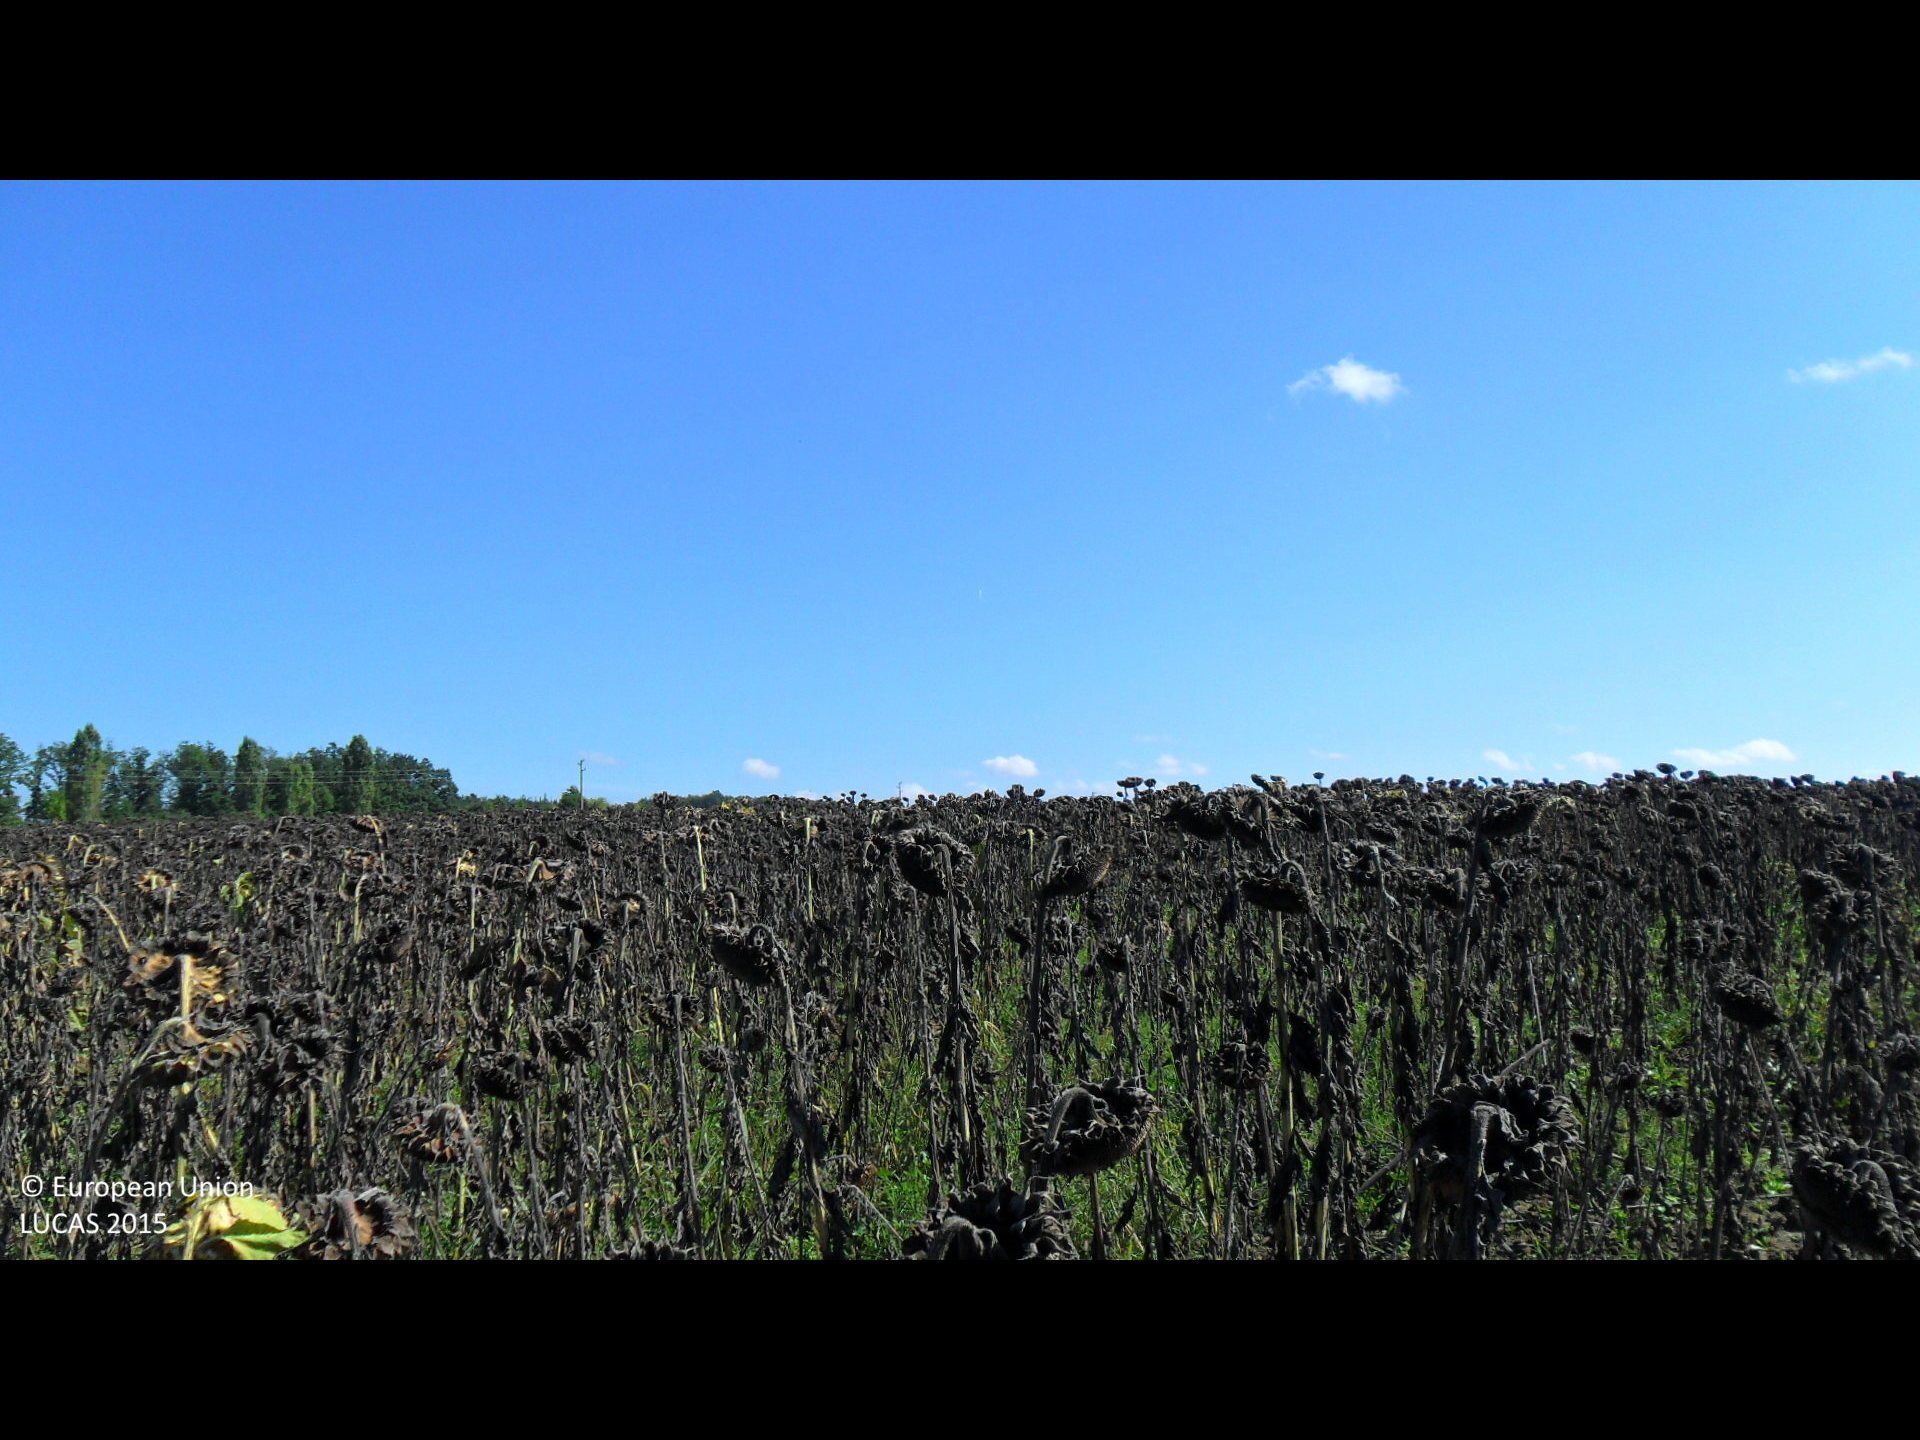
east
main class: Cropland
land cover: Sunflower
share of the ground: > 75 %
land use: Agriculture (excluding fallow land and kitchen gardens)
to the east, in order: Sunflower
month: October
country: BG
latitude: 43.1351
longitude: 26.2356
